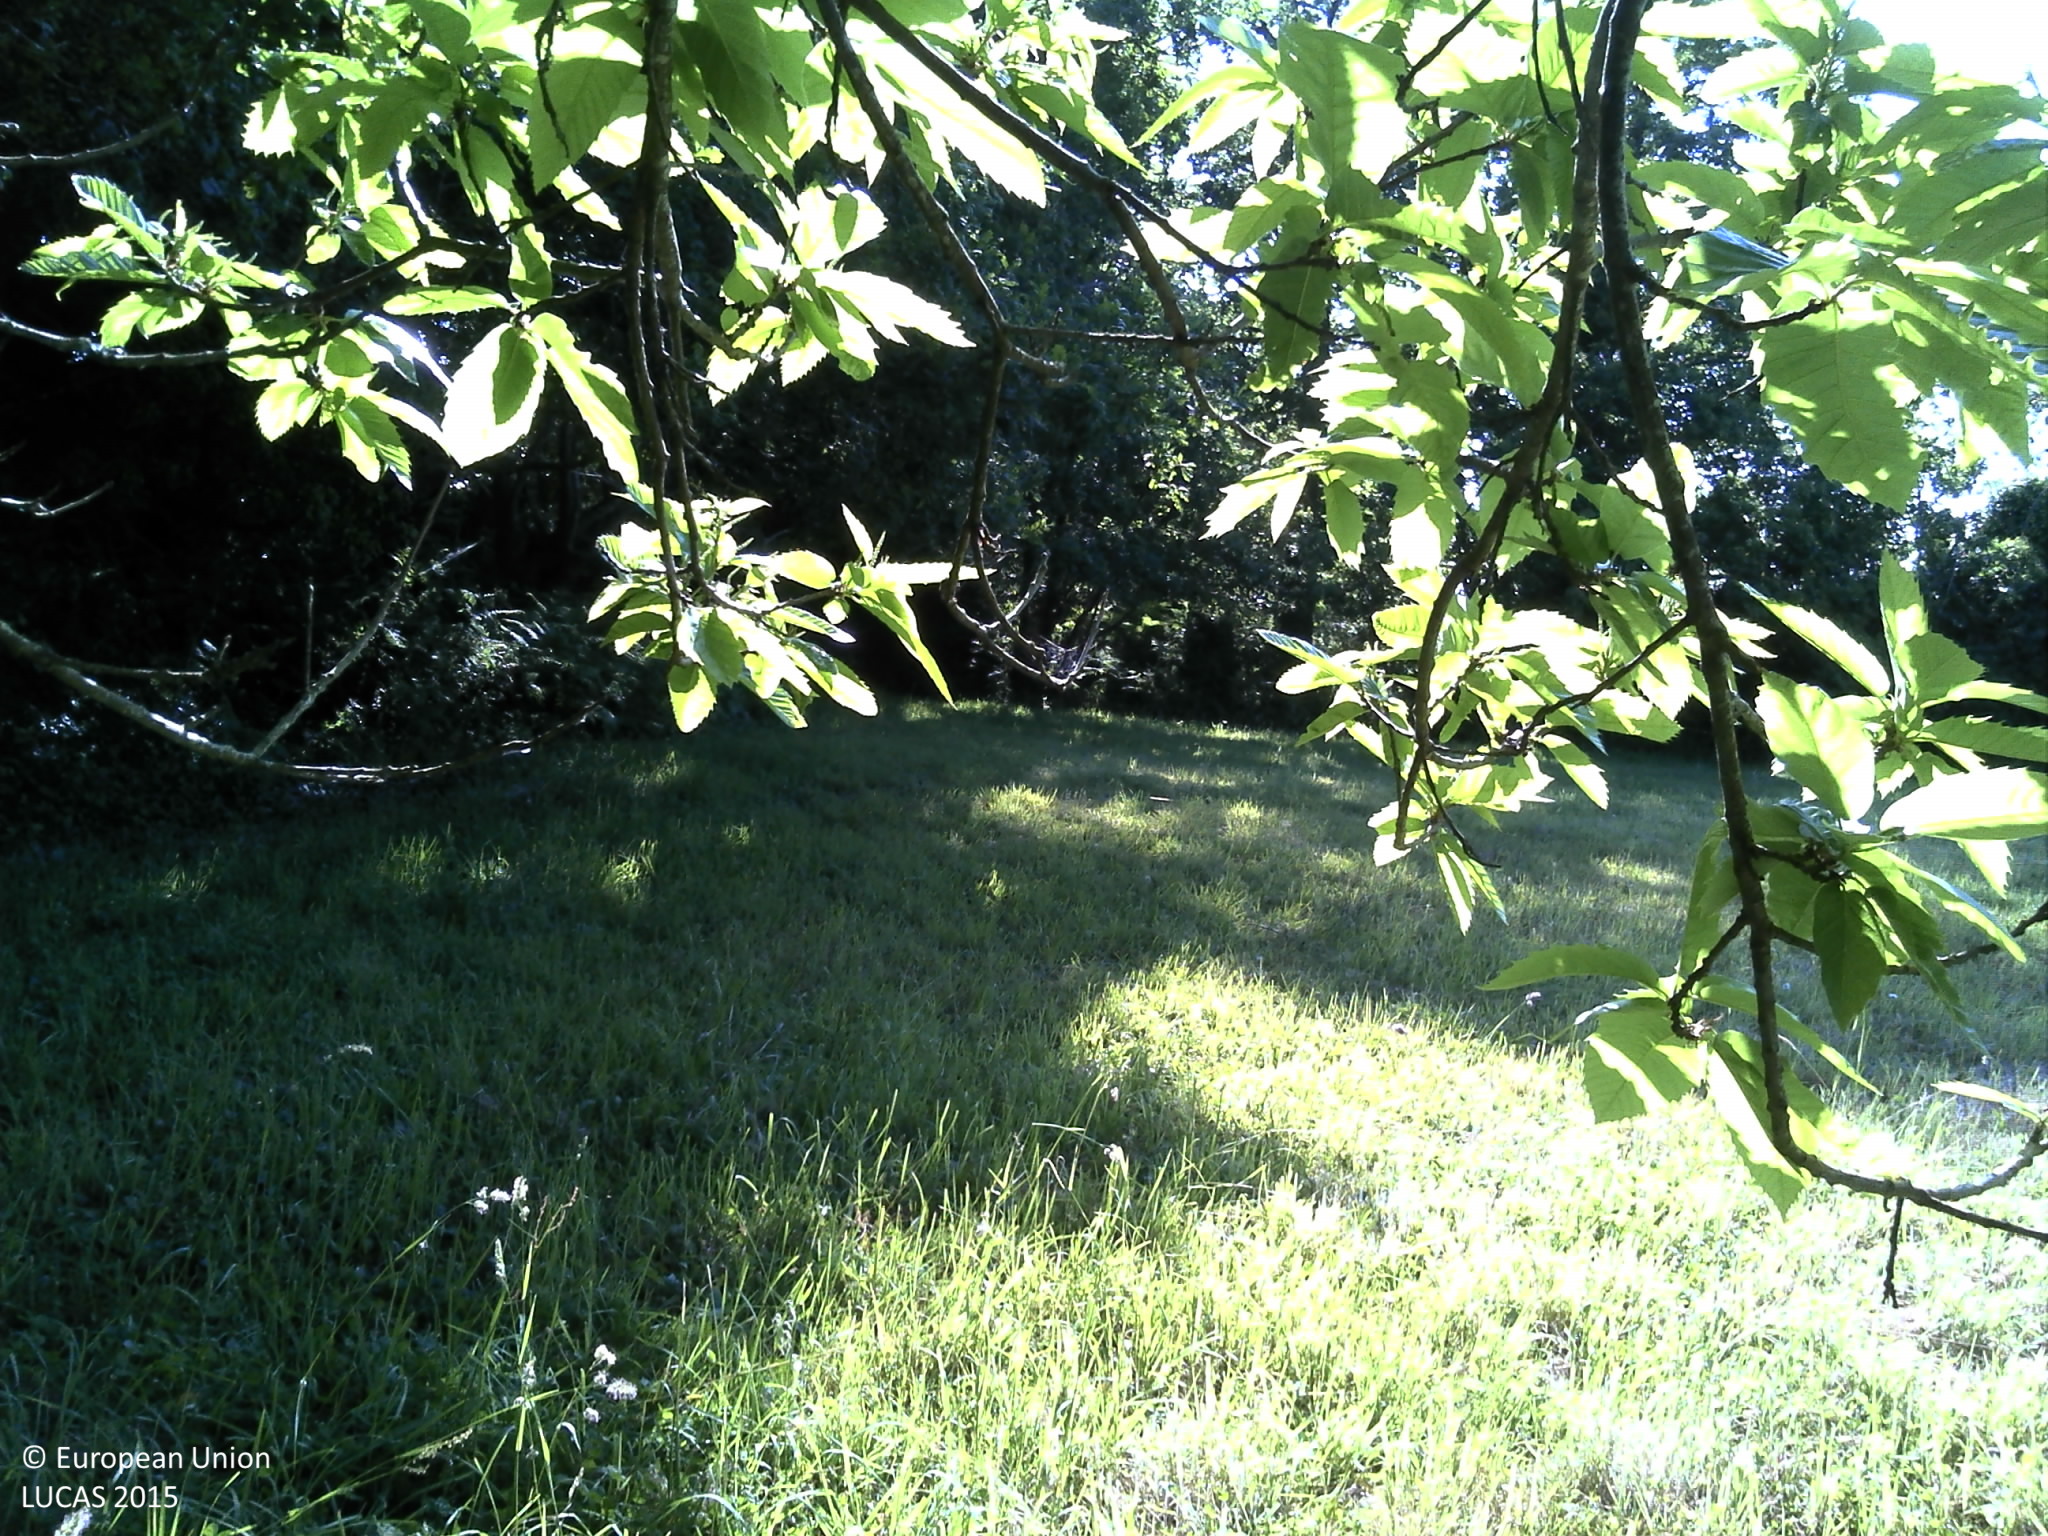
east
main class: Grassland
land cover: Grassland without tree/shrub cover
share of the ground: > 75 %
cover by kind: herbaceous plants 100 %
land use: Residential
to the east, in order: Grassland without tree/shrub cover; Broadleaved woodland; Tracks; Lines of trees; Tracks; Broadleaved woodland; Grassland without tree/shrub cover; Lines of trees; Grassland without tree/shrub cover; Broadleaved woodland; Grass margins; Triticale
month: June
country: FR
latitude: 47.8794
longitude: -4.0873
